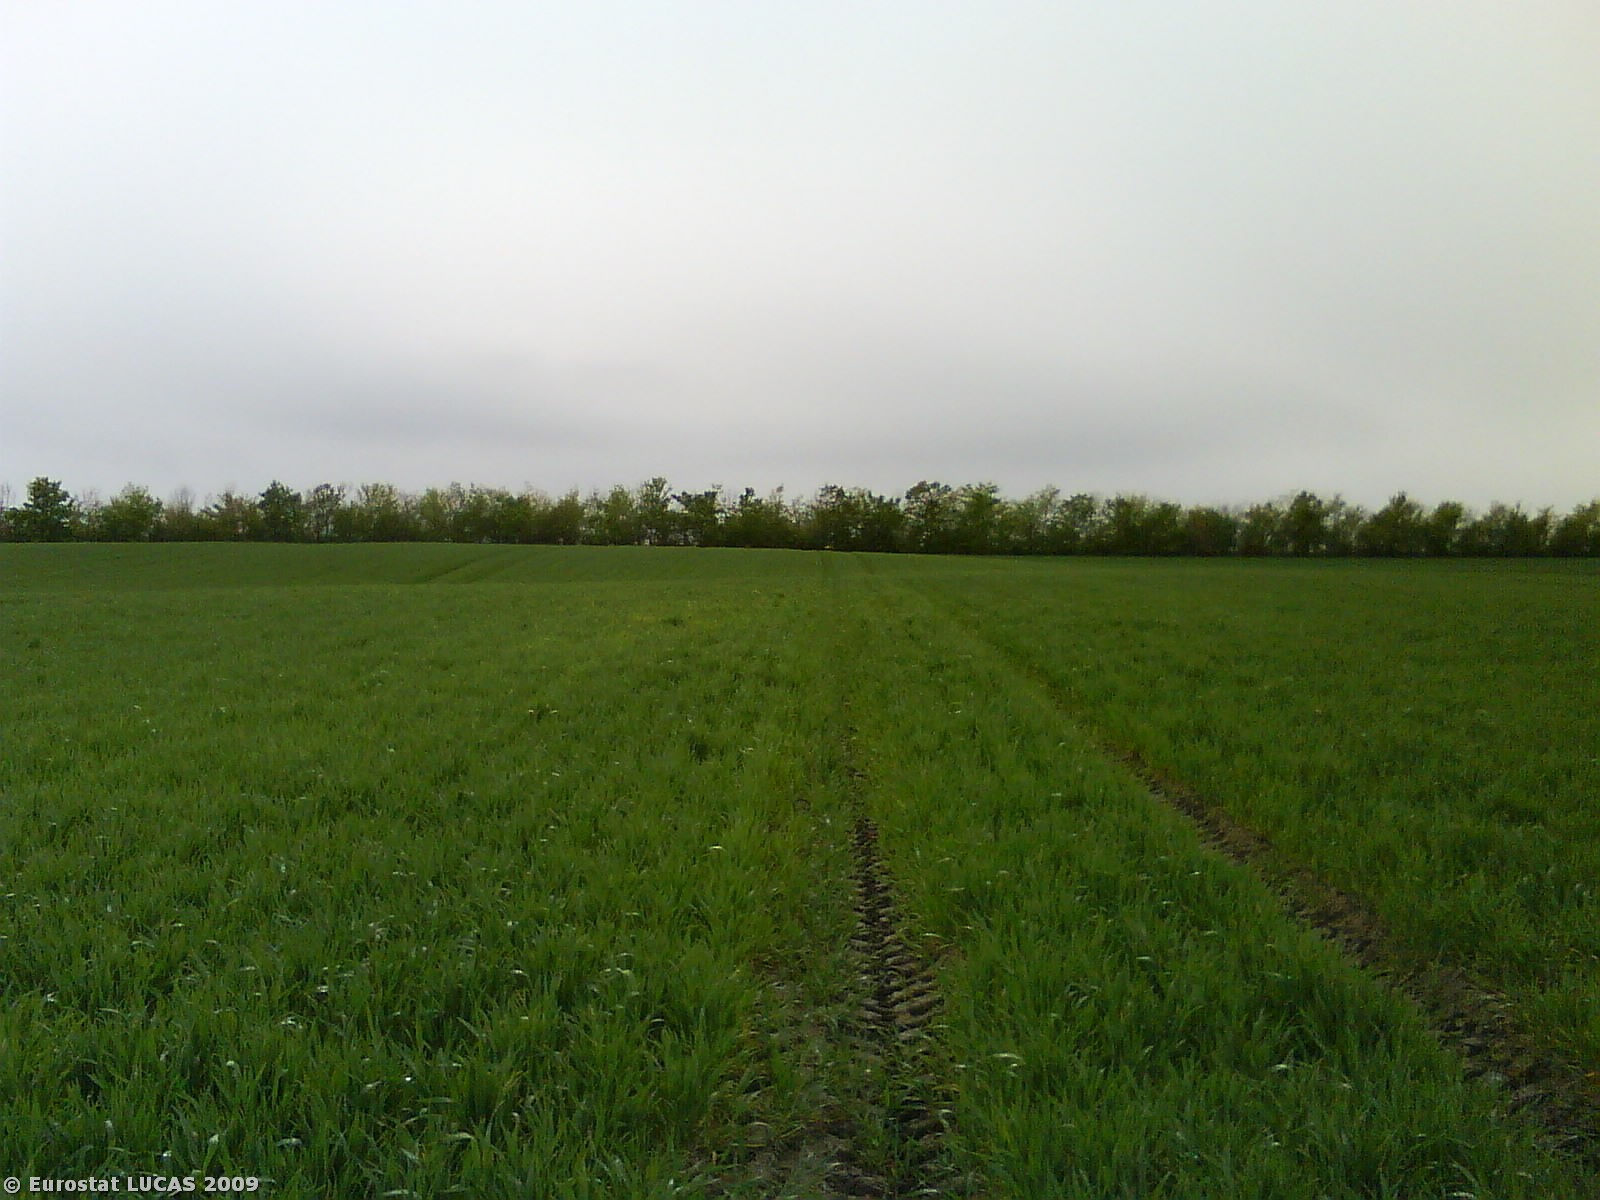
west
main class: Cropland
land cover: Common wheat
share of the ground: > 75 %
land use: Agriculture (excluding fallow land and kitchen gardens)
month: May
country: DK
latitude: 56.3314
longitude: 10.2100
